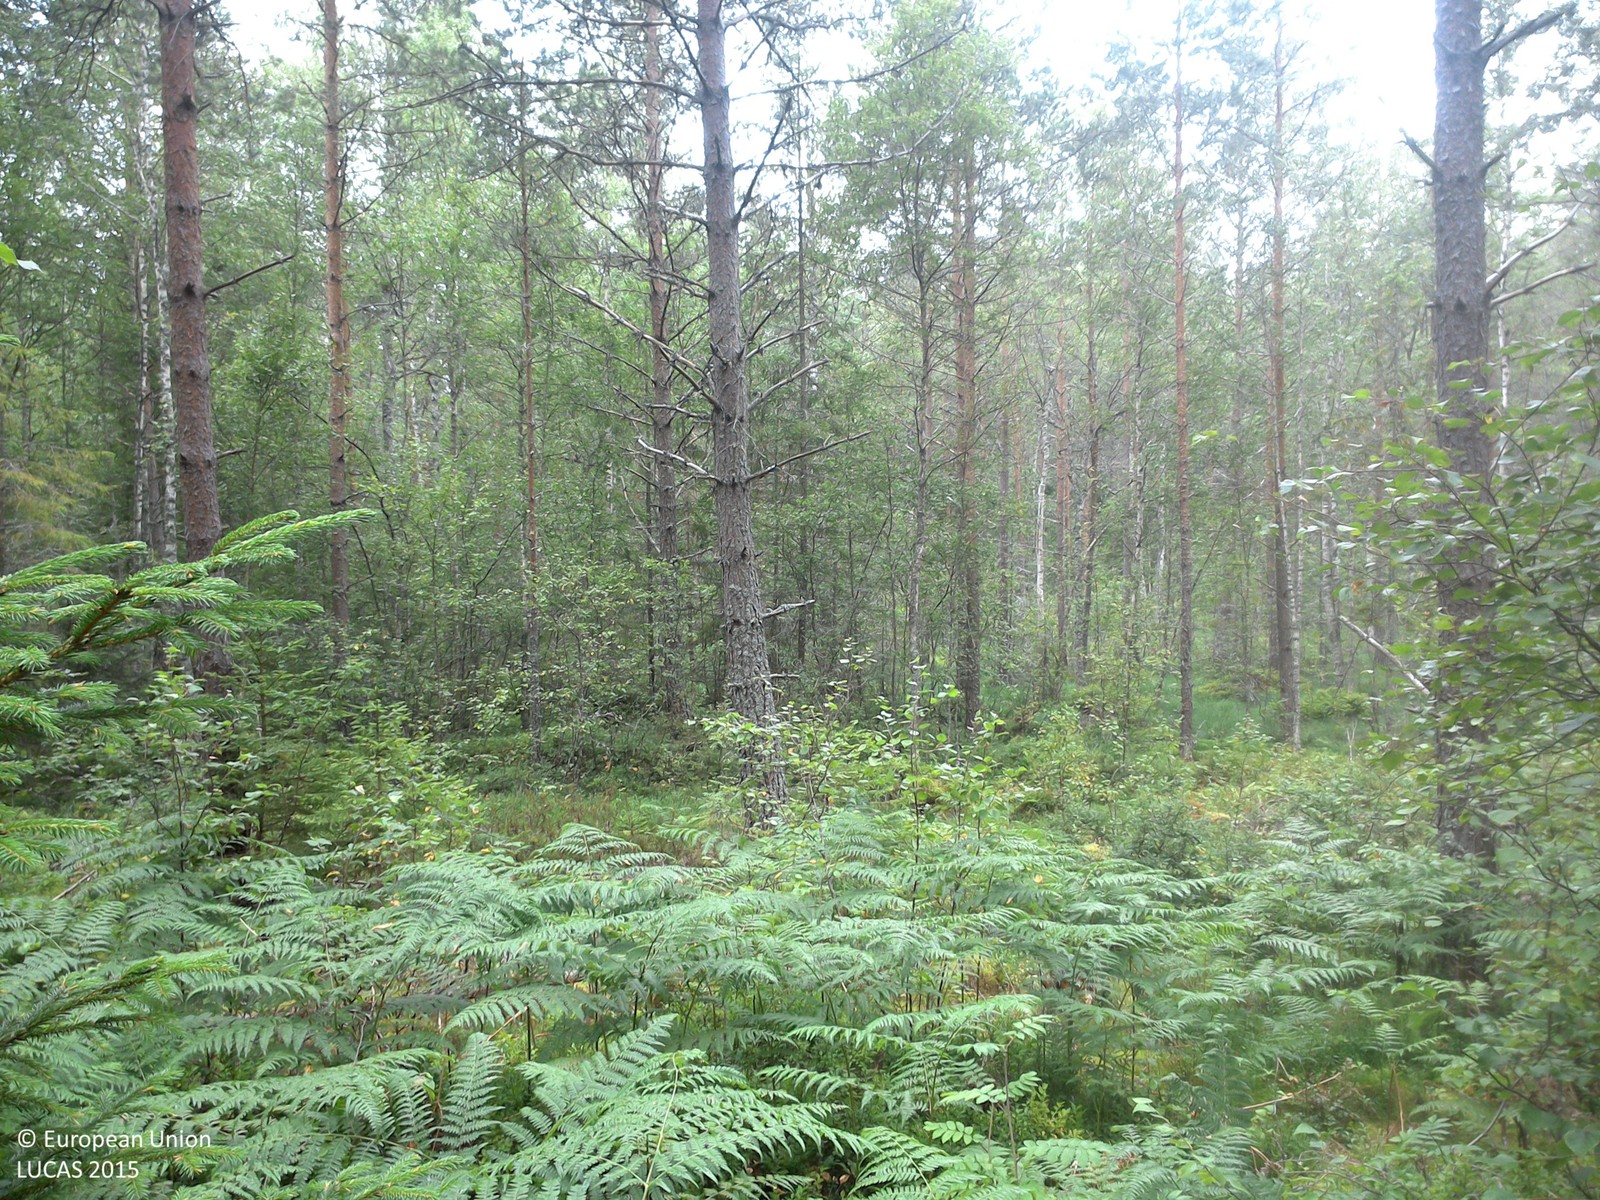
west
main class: Woodland
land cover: Pine dominated coniferous woodland
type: boreal forest
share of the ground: 25 - 50 %
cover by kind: herbaceous plants 50 %, coniferous forest trees 35 %, lichens and mosses 15 %
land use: Forestry
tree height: > 5 m
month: August
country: SE
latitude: 57.8253
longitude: 15.3332
